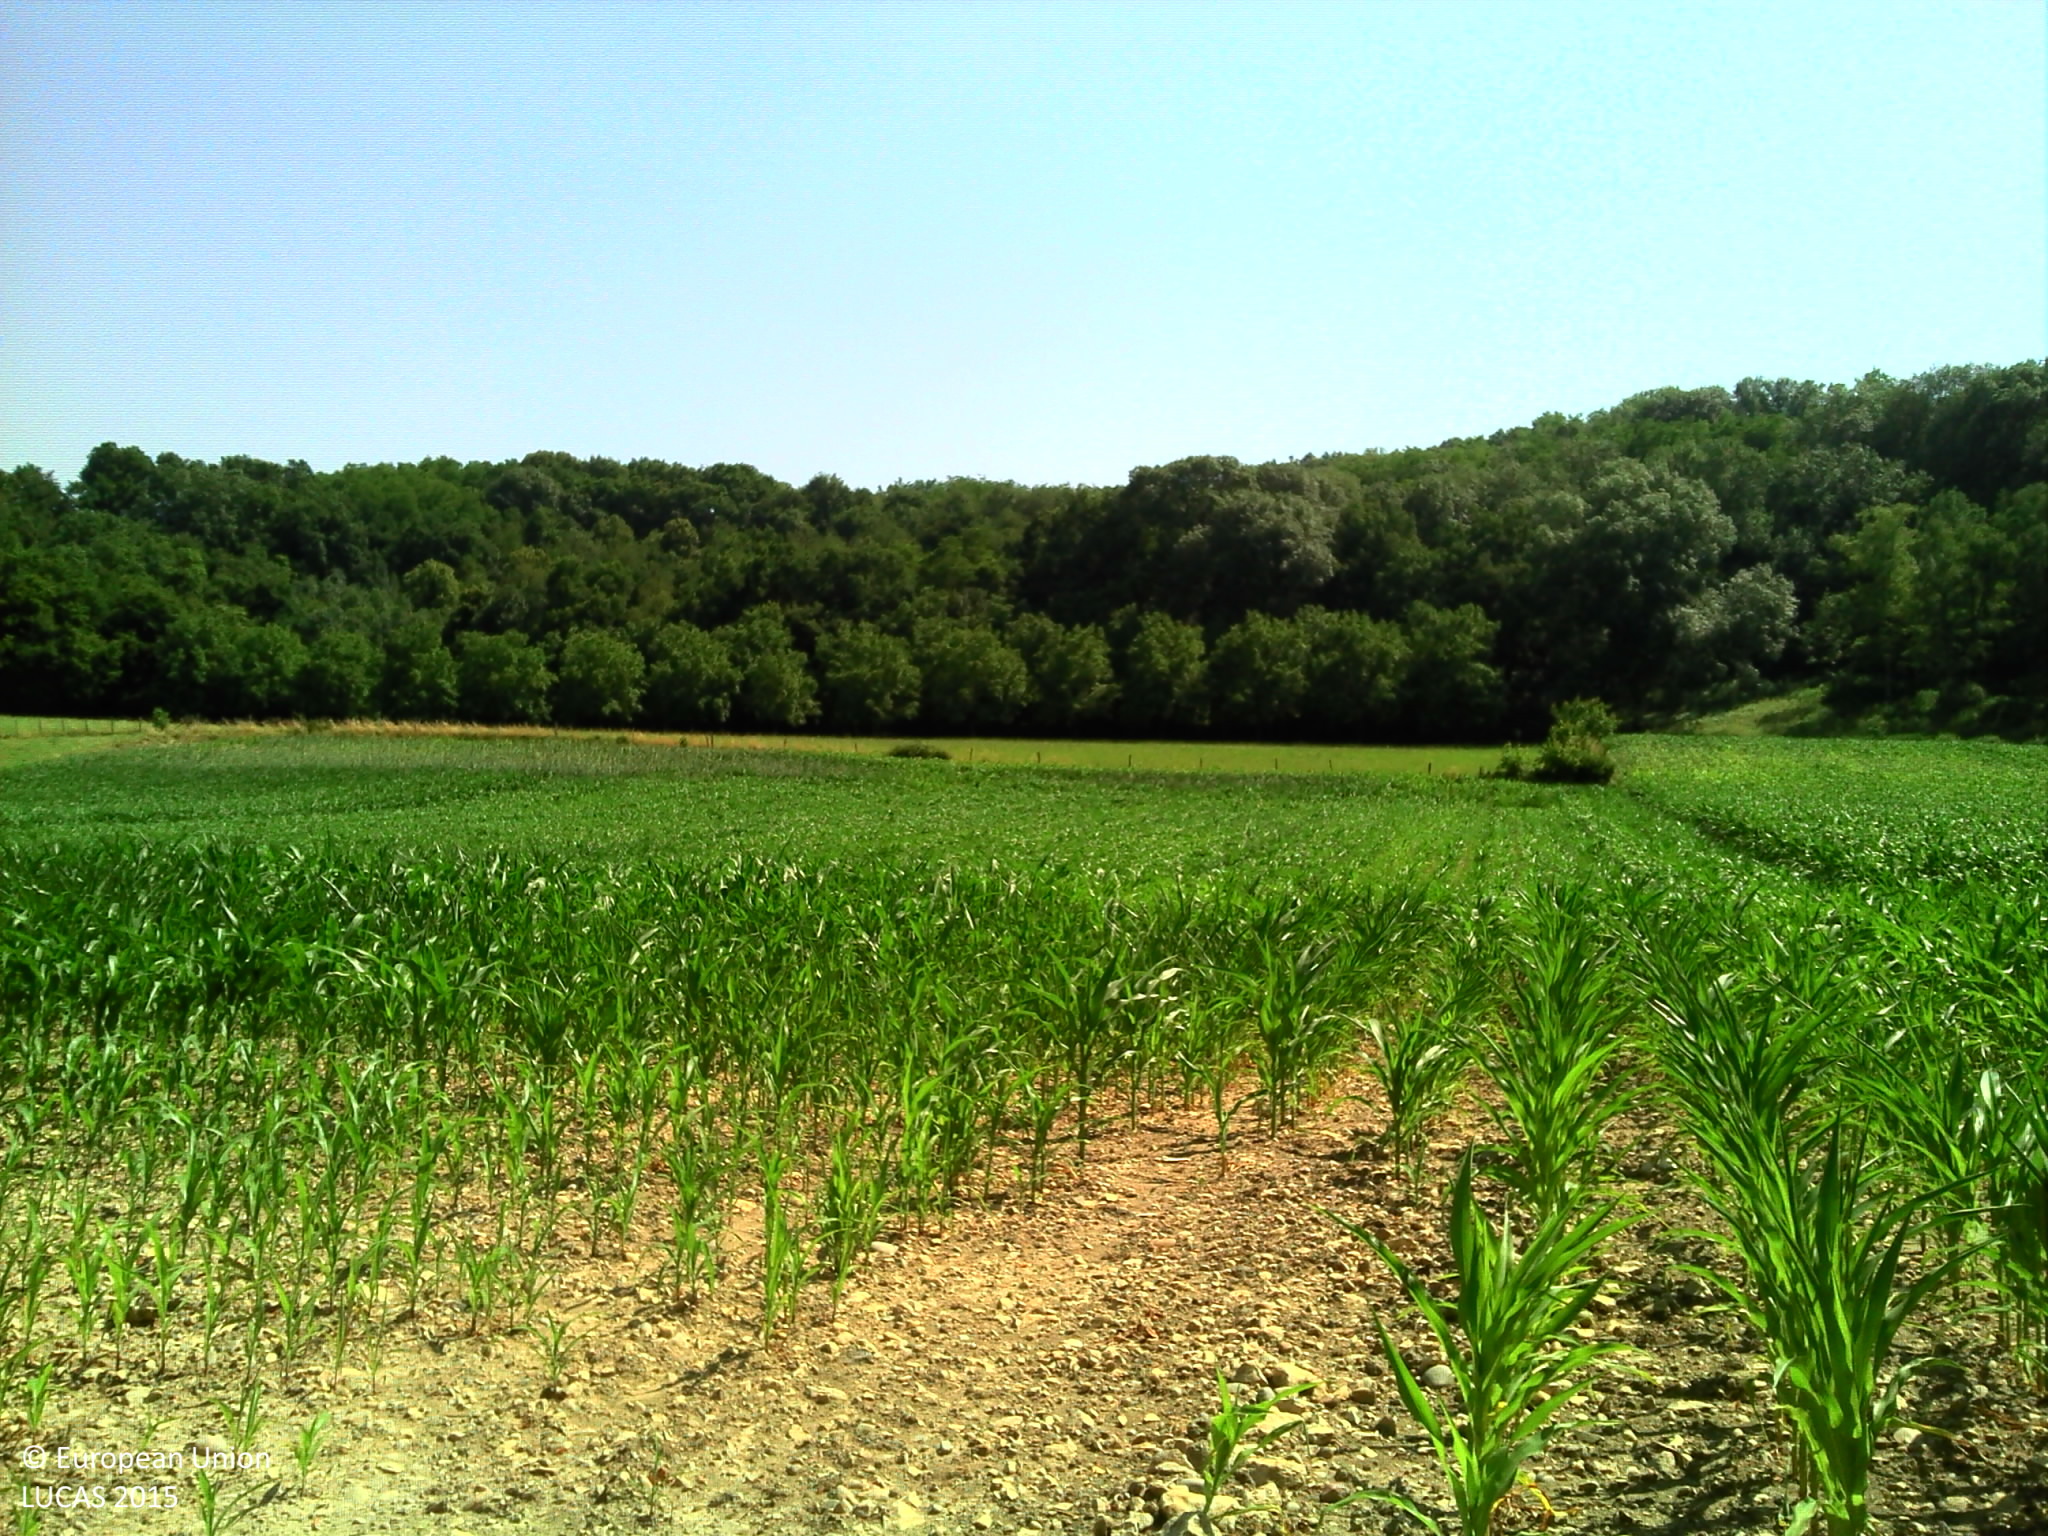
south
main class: Woodland
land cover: Broadleaved woodland
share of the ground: > 75 %
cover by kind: broadleaved forest trees 90 %, herbaceous plants 10 %
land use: Semi-natural and natural areas not in use
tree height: > 5 m
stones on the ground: < 10 %
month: July
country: FR
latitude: 45.6388
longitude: 5.3986
